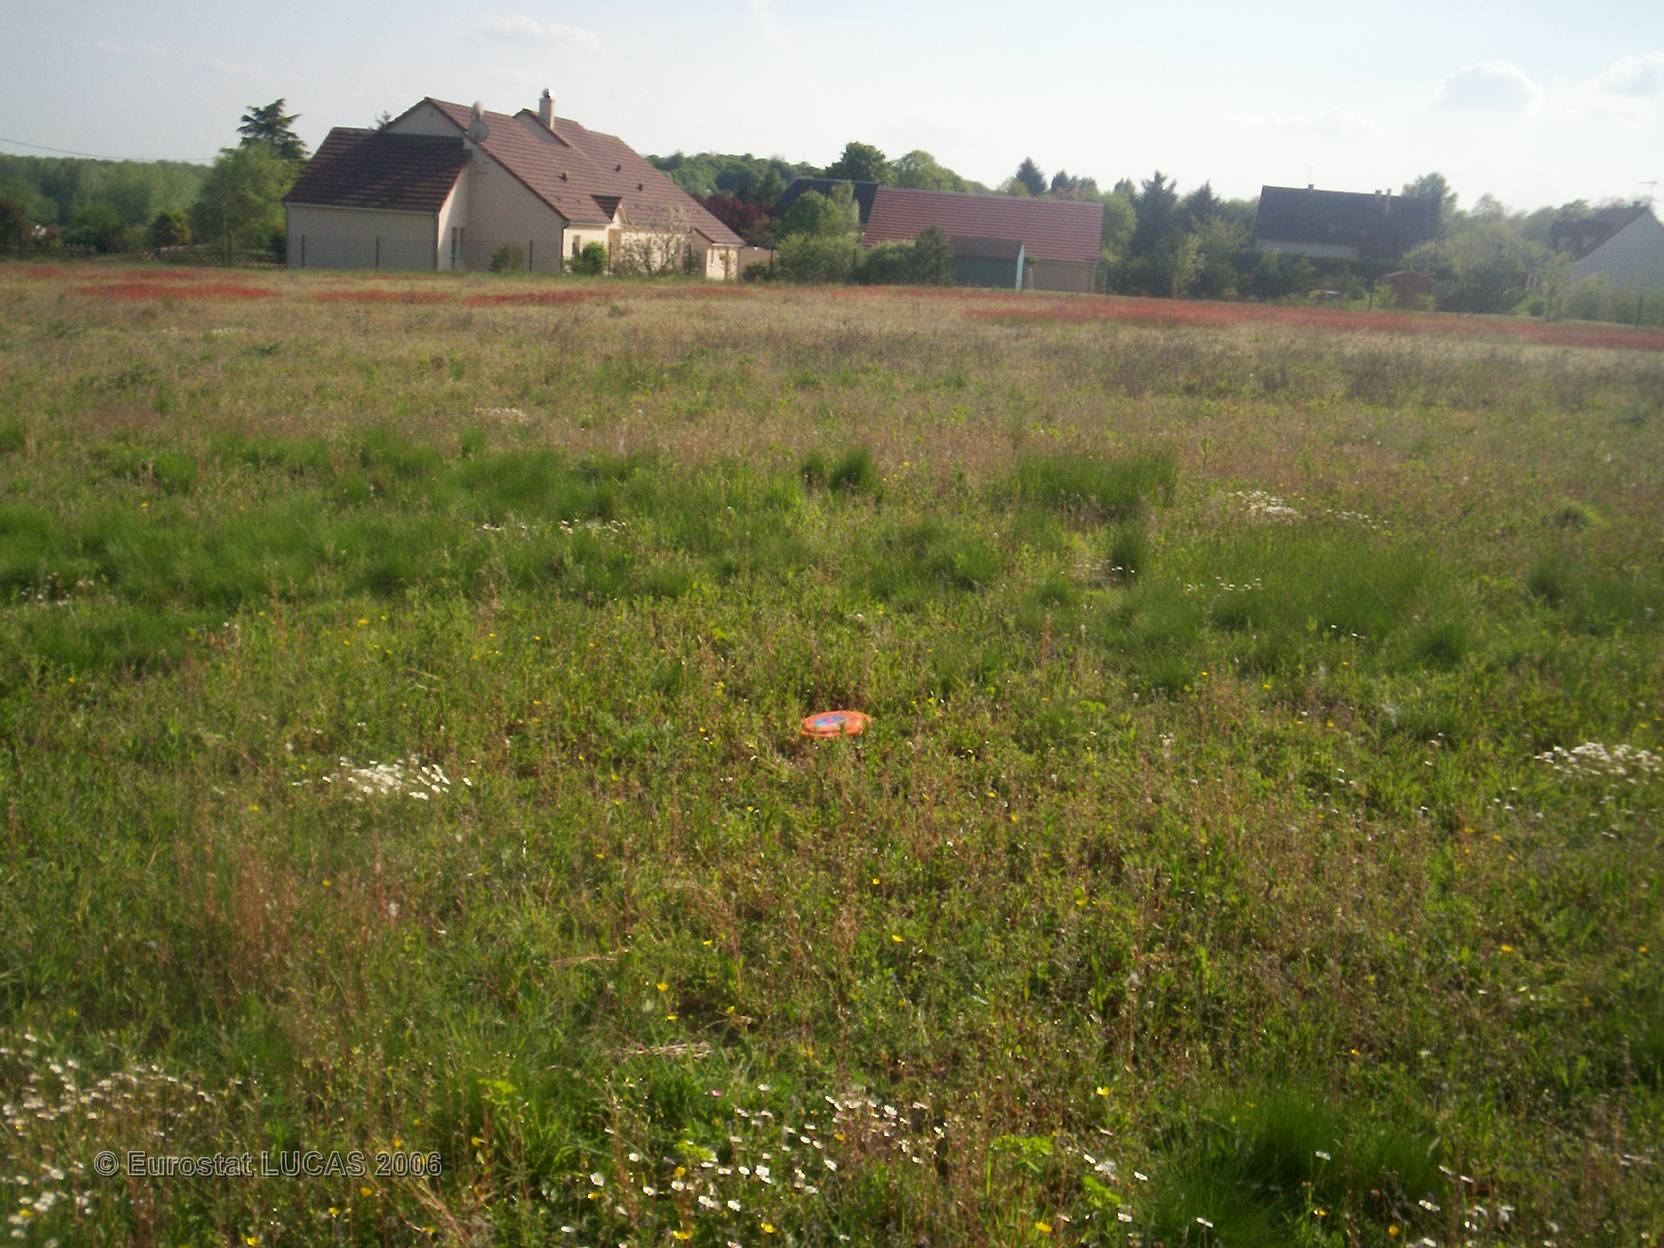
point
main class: Grassland
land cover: Grassland without tree/shrub cover
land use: Agriculture (excluding fallow land and kitchen gardens)
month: May
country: FR
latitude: 47.5475
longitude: 1.2278
